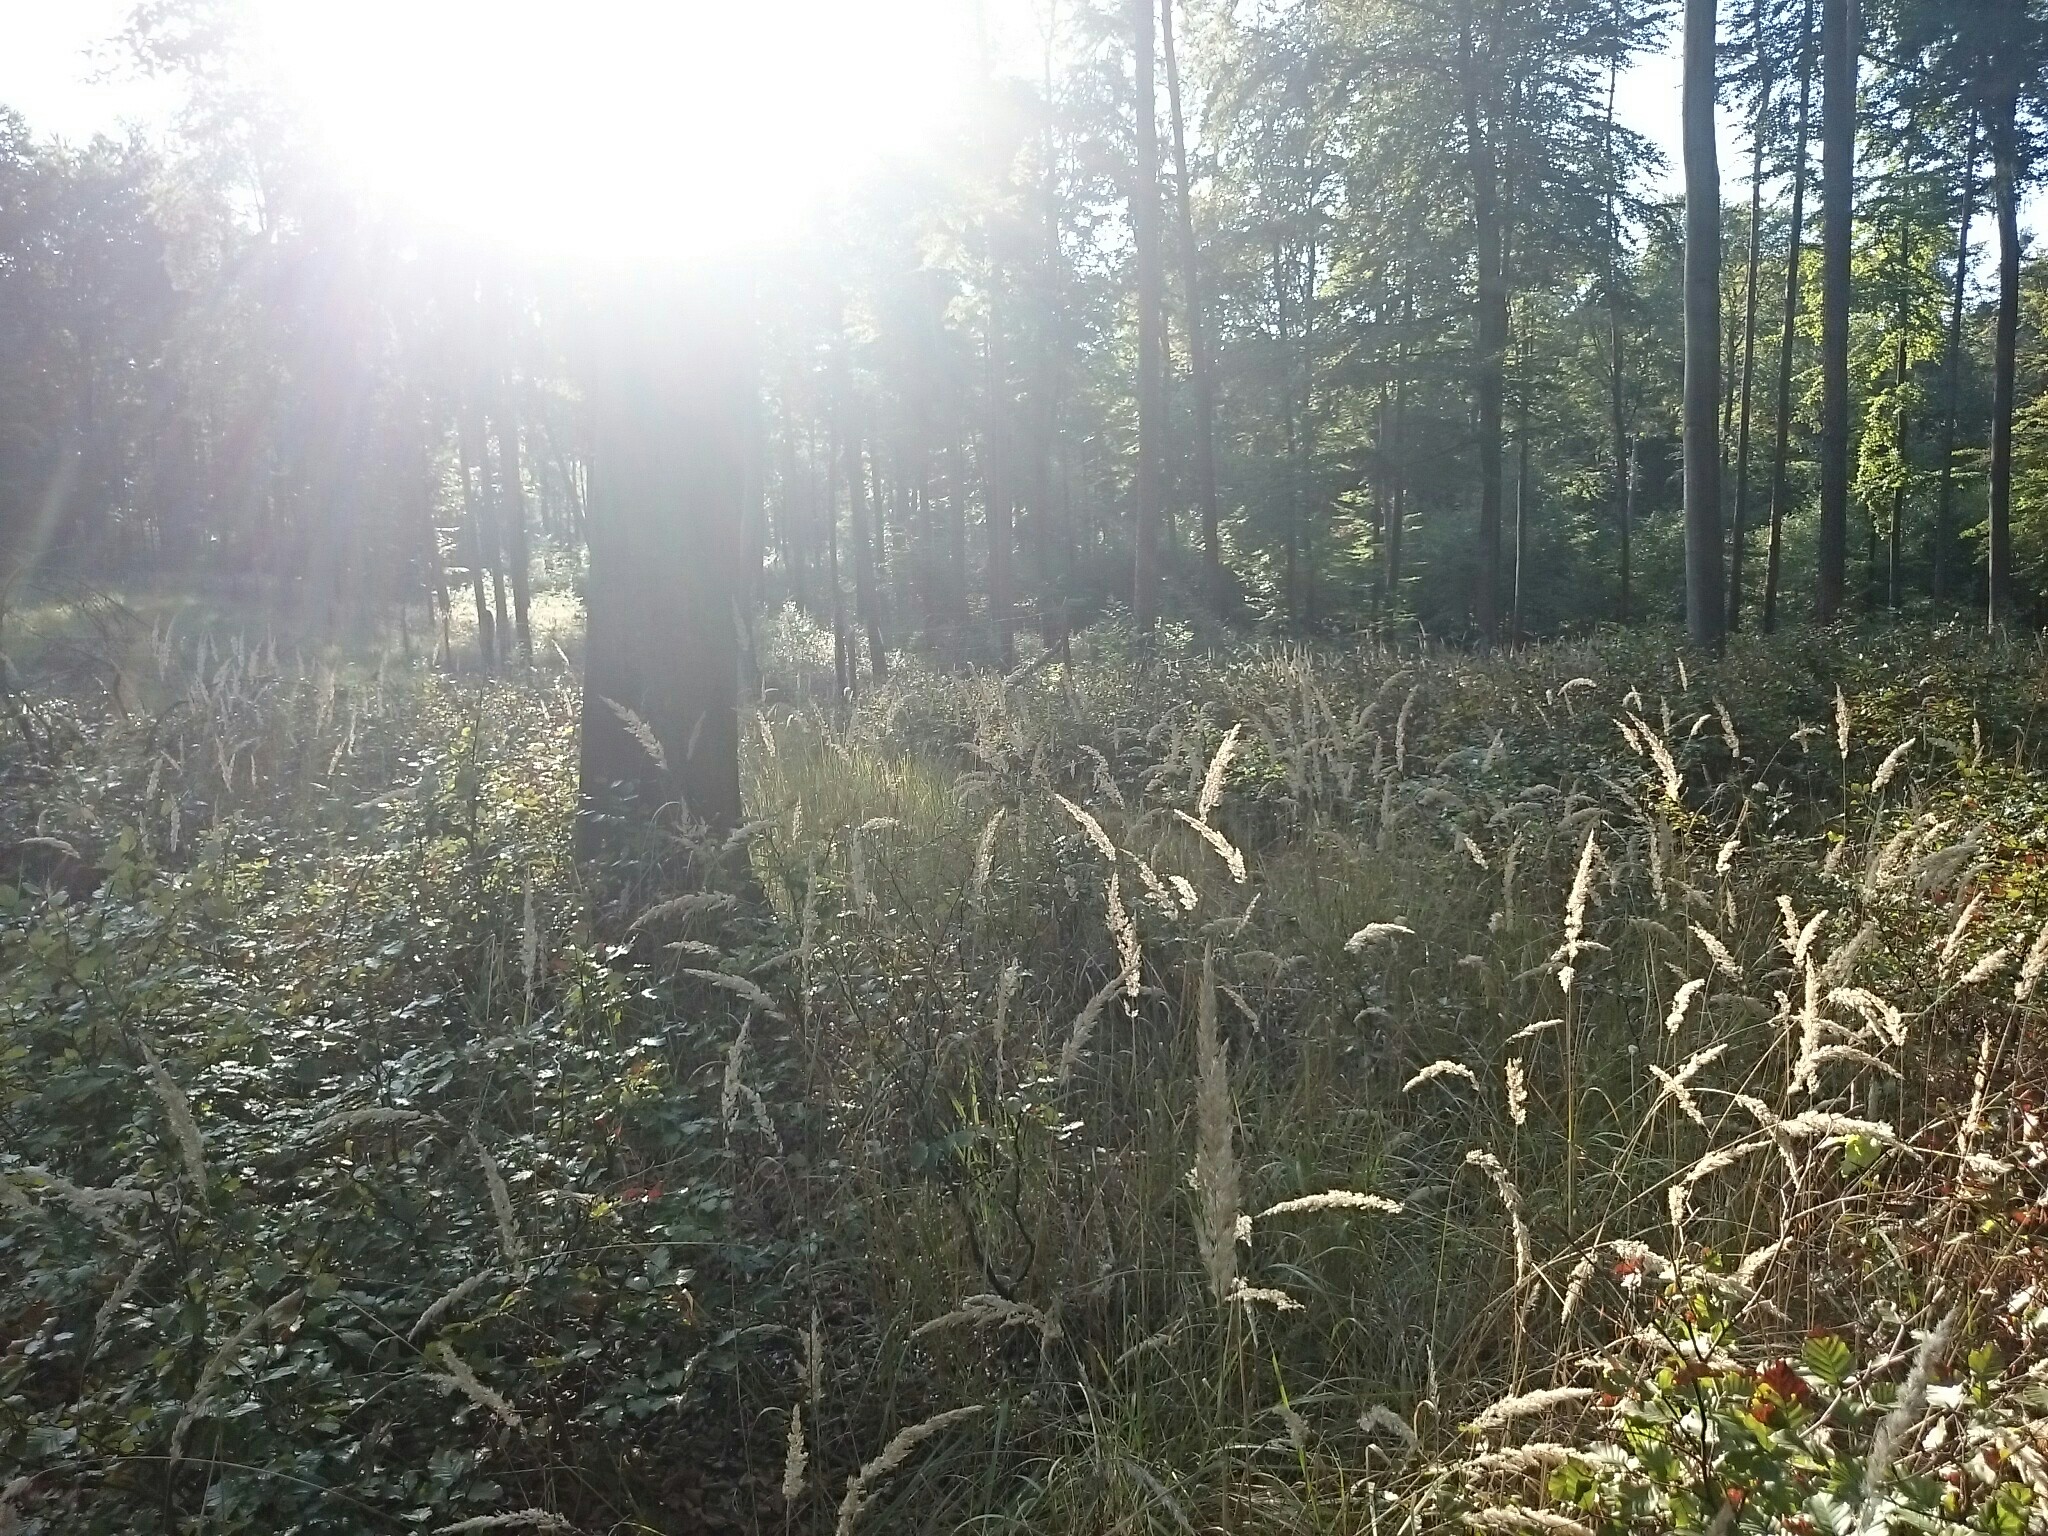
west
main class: Woodland
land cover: Pine dominated mixed woodland
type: hemiboreal forest and nemoral coniferous forest and mixed broadleaved-coniferous forest
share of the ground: 50 - 75 %
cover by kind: herbaceous plants 45 %, coniferous forest trees 30 %, broadleaved forest trees 25 %
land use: Forestry
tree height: > 5 m
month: September
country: PL
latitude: 51.3391
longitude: 17.3184
